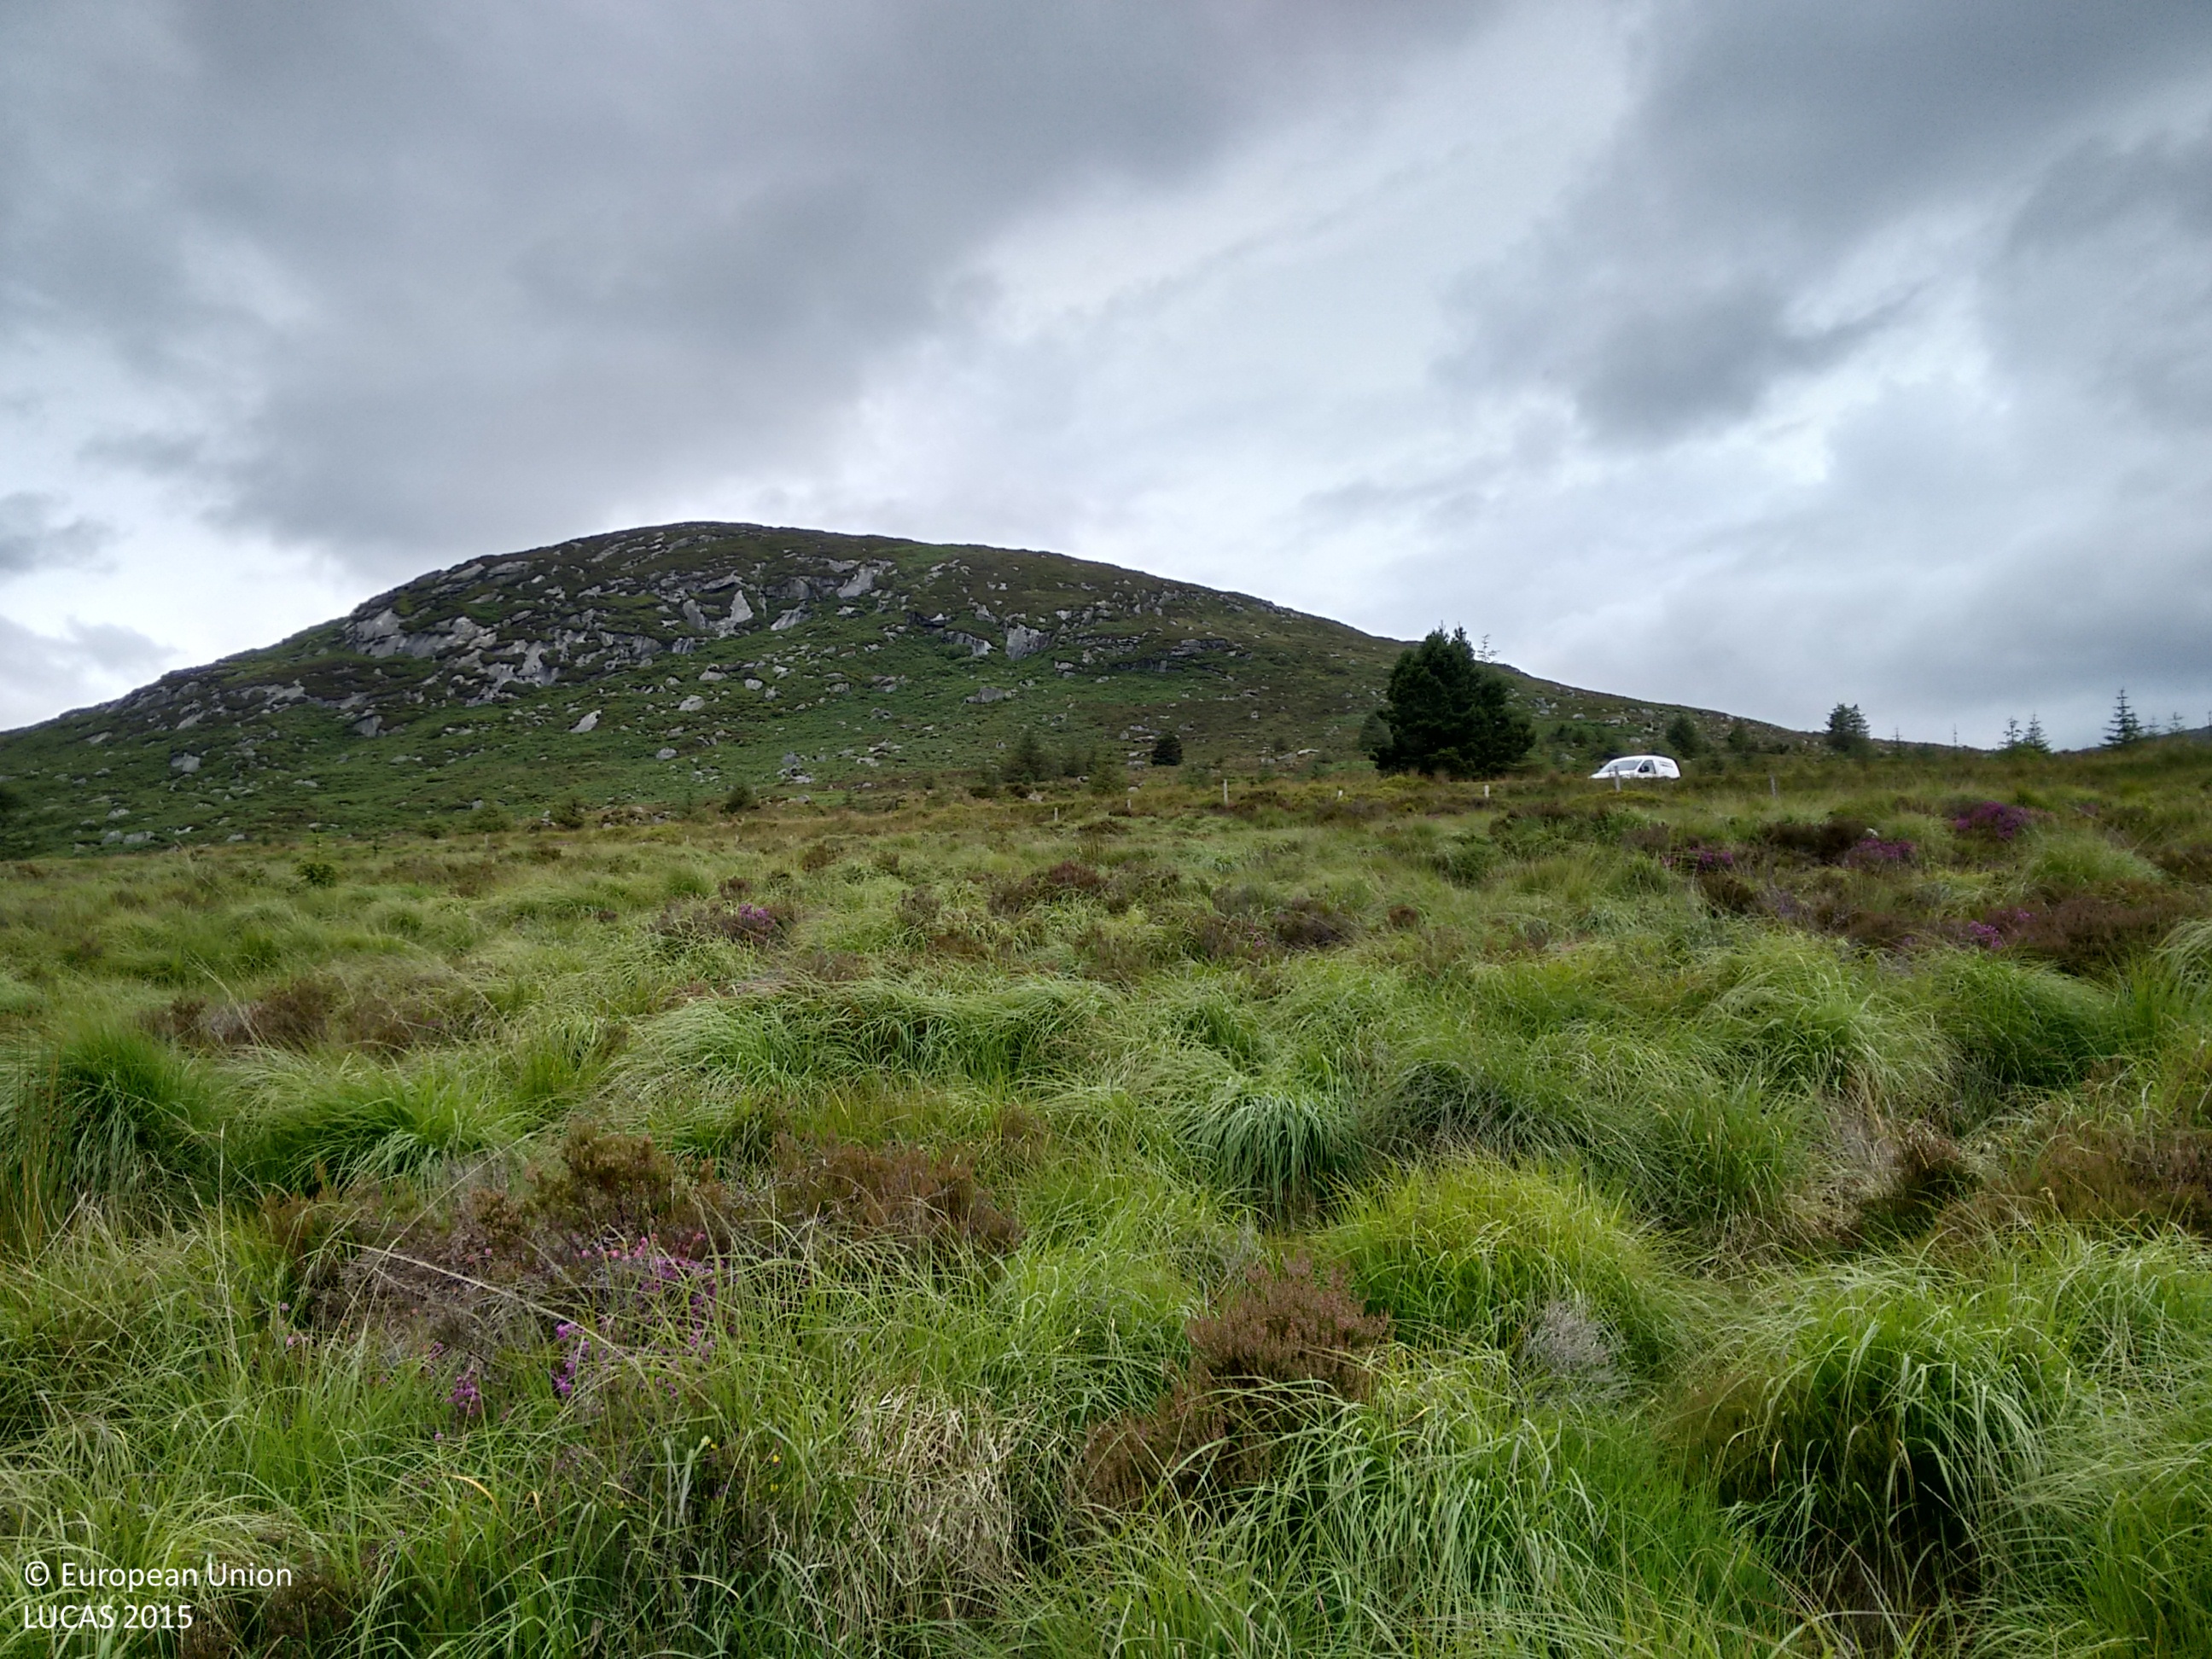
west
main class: Shrubland
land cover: Shrubland without tree cover
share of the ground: > 75 %
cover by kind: shrubs 60 %, herbaceous plants 40 %
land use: Semi-natural and natural areas not in use
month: July
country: IE
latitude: 53.0875
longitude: -6.3527
